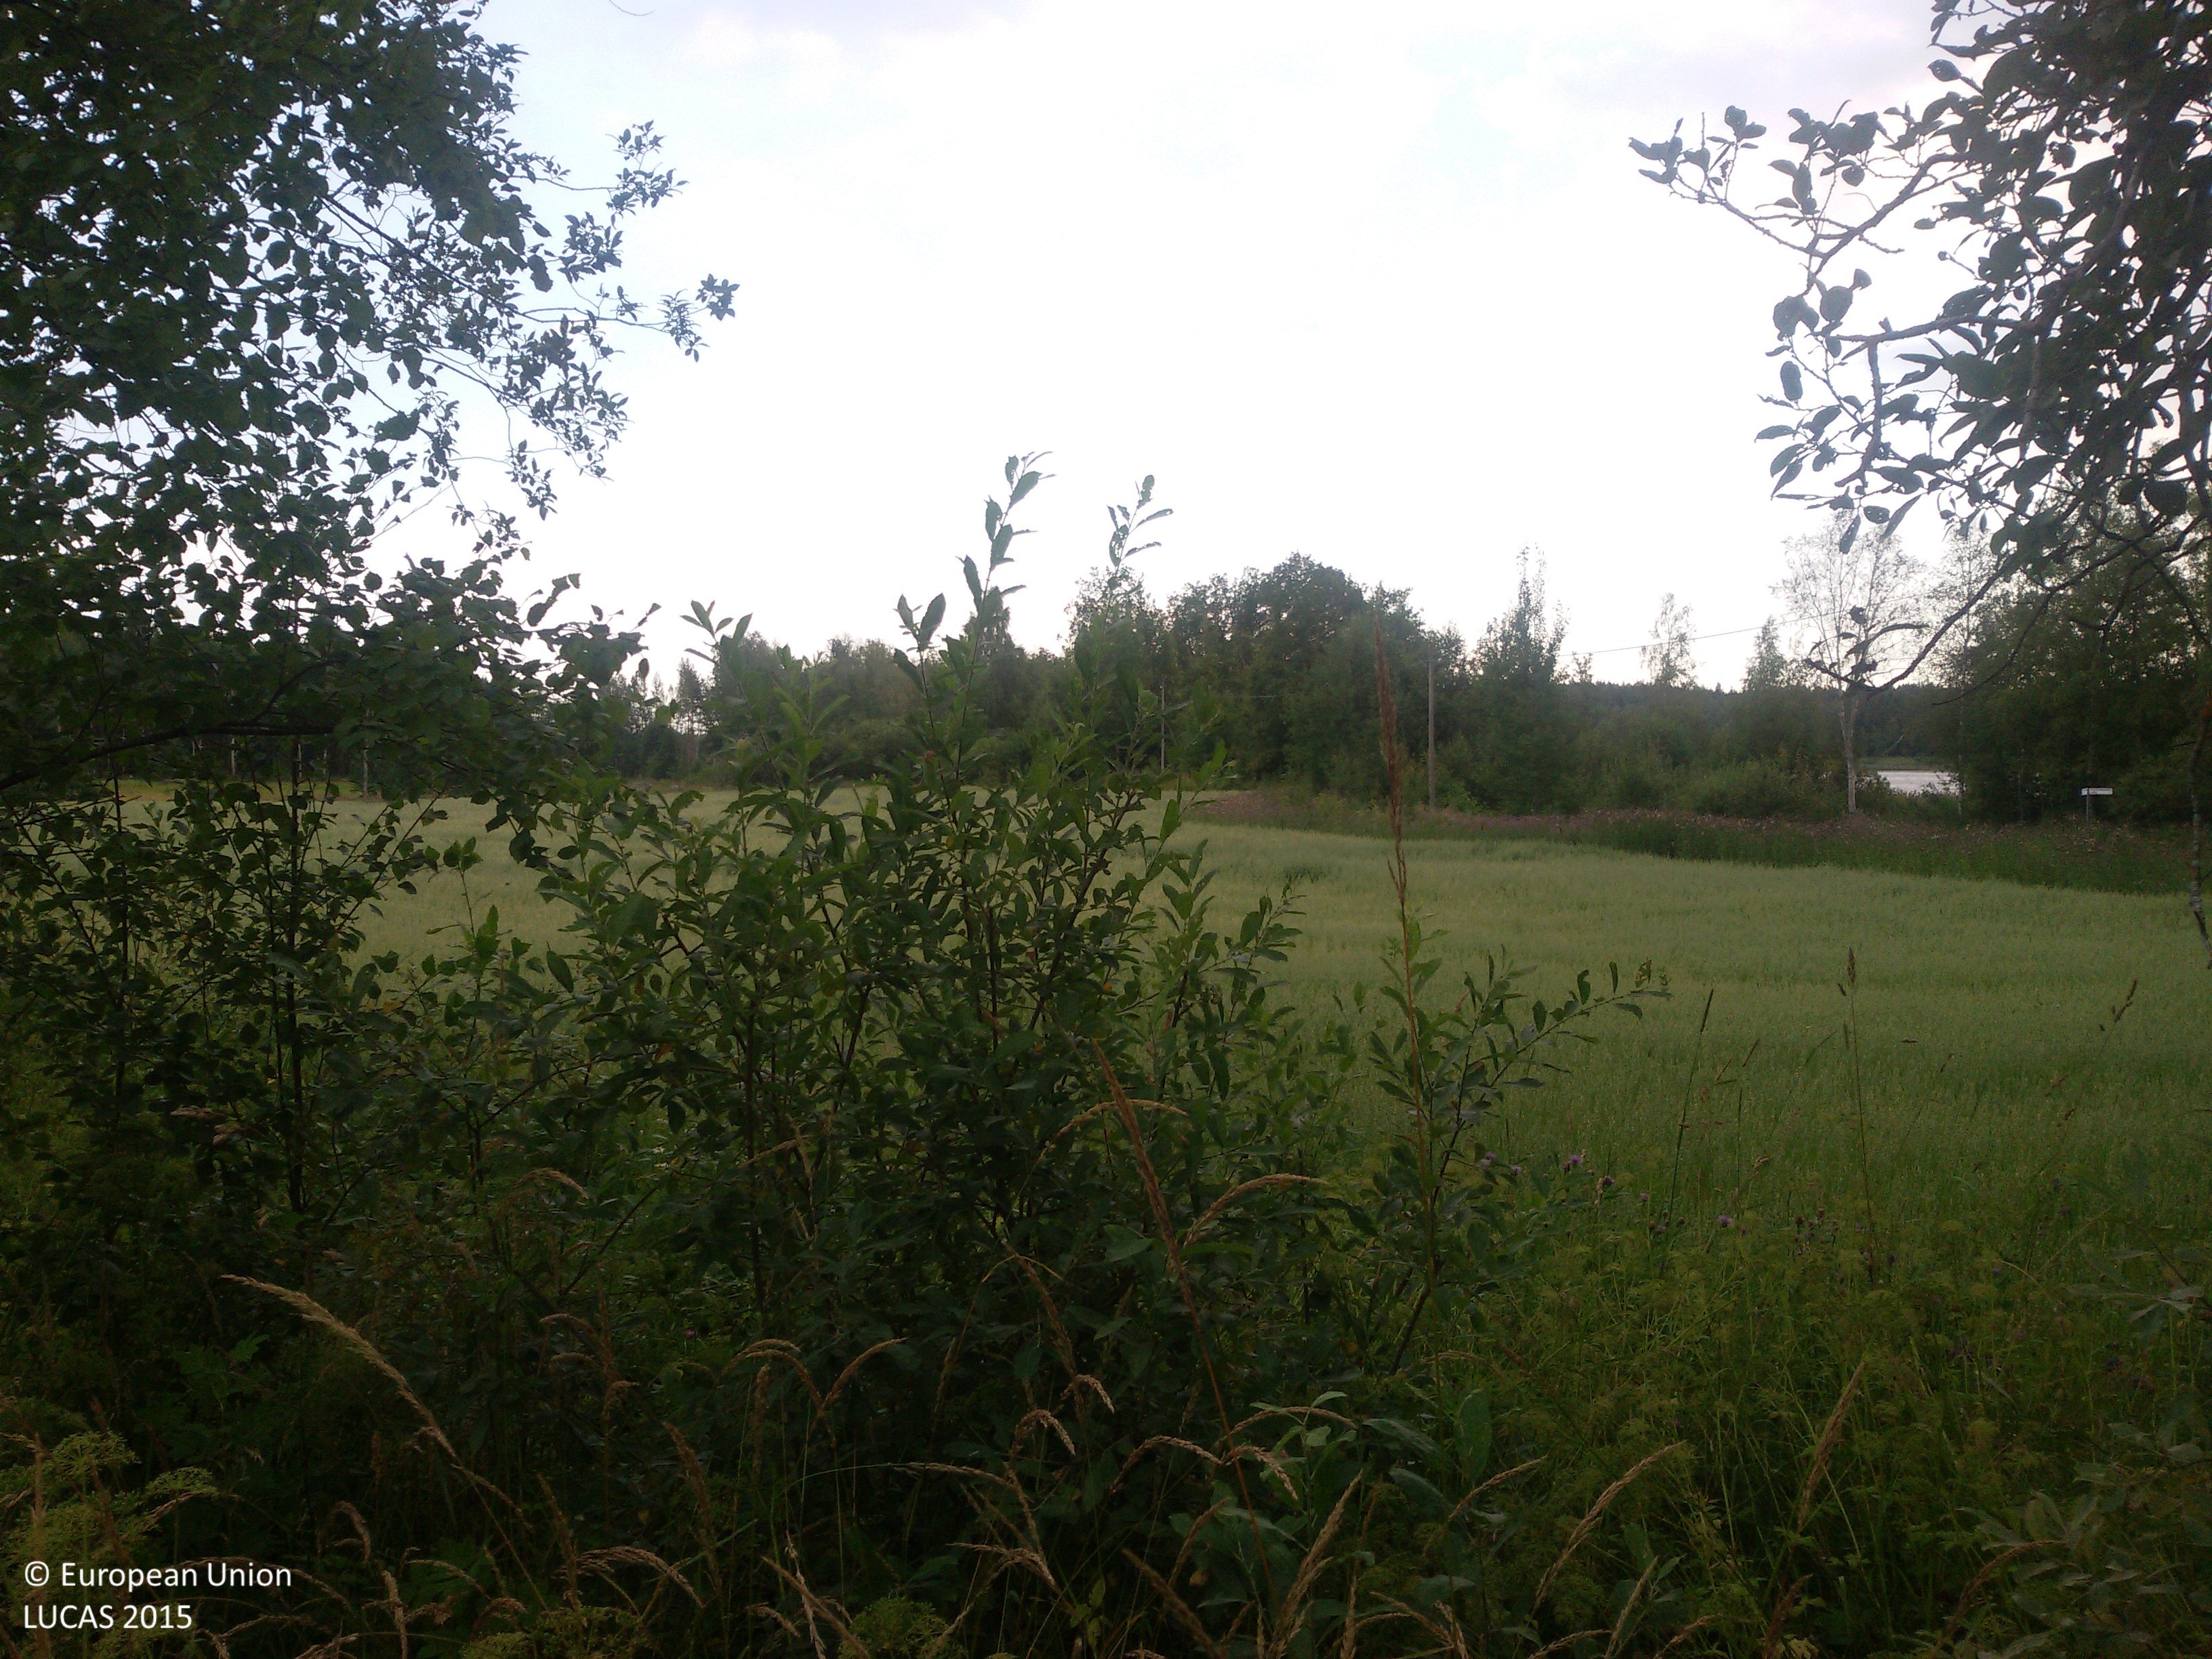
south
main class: Woodland
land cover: Broadleaved woodland
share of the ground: 25 - 50 %
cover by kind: herbaceous plants 50 %, broadleaved forest trees 30 %, shrubs 20 %
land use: Semi-natural and natural areas not in use
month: August
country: SE
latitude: 60.5337
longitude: 16.5675
